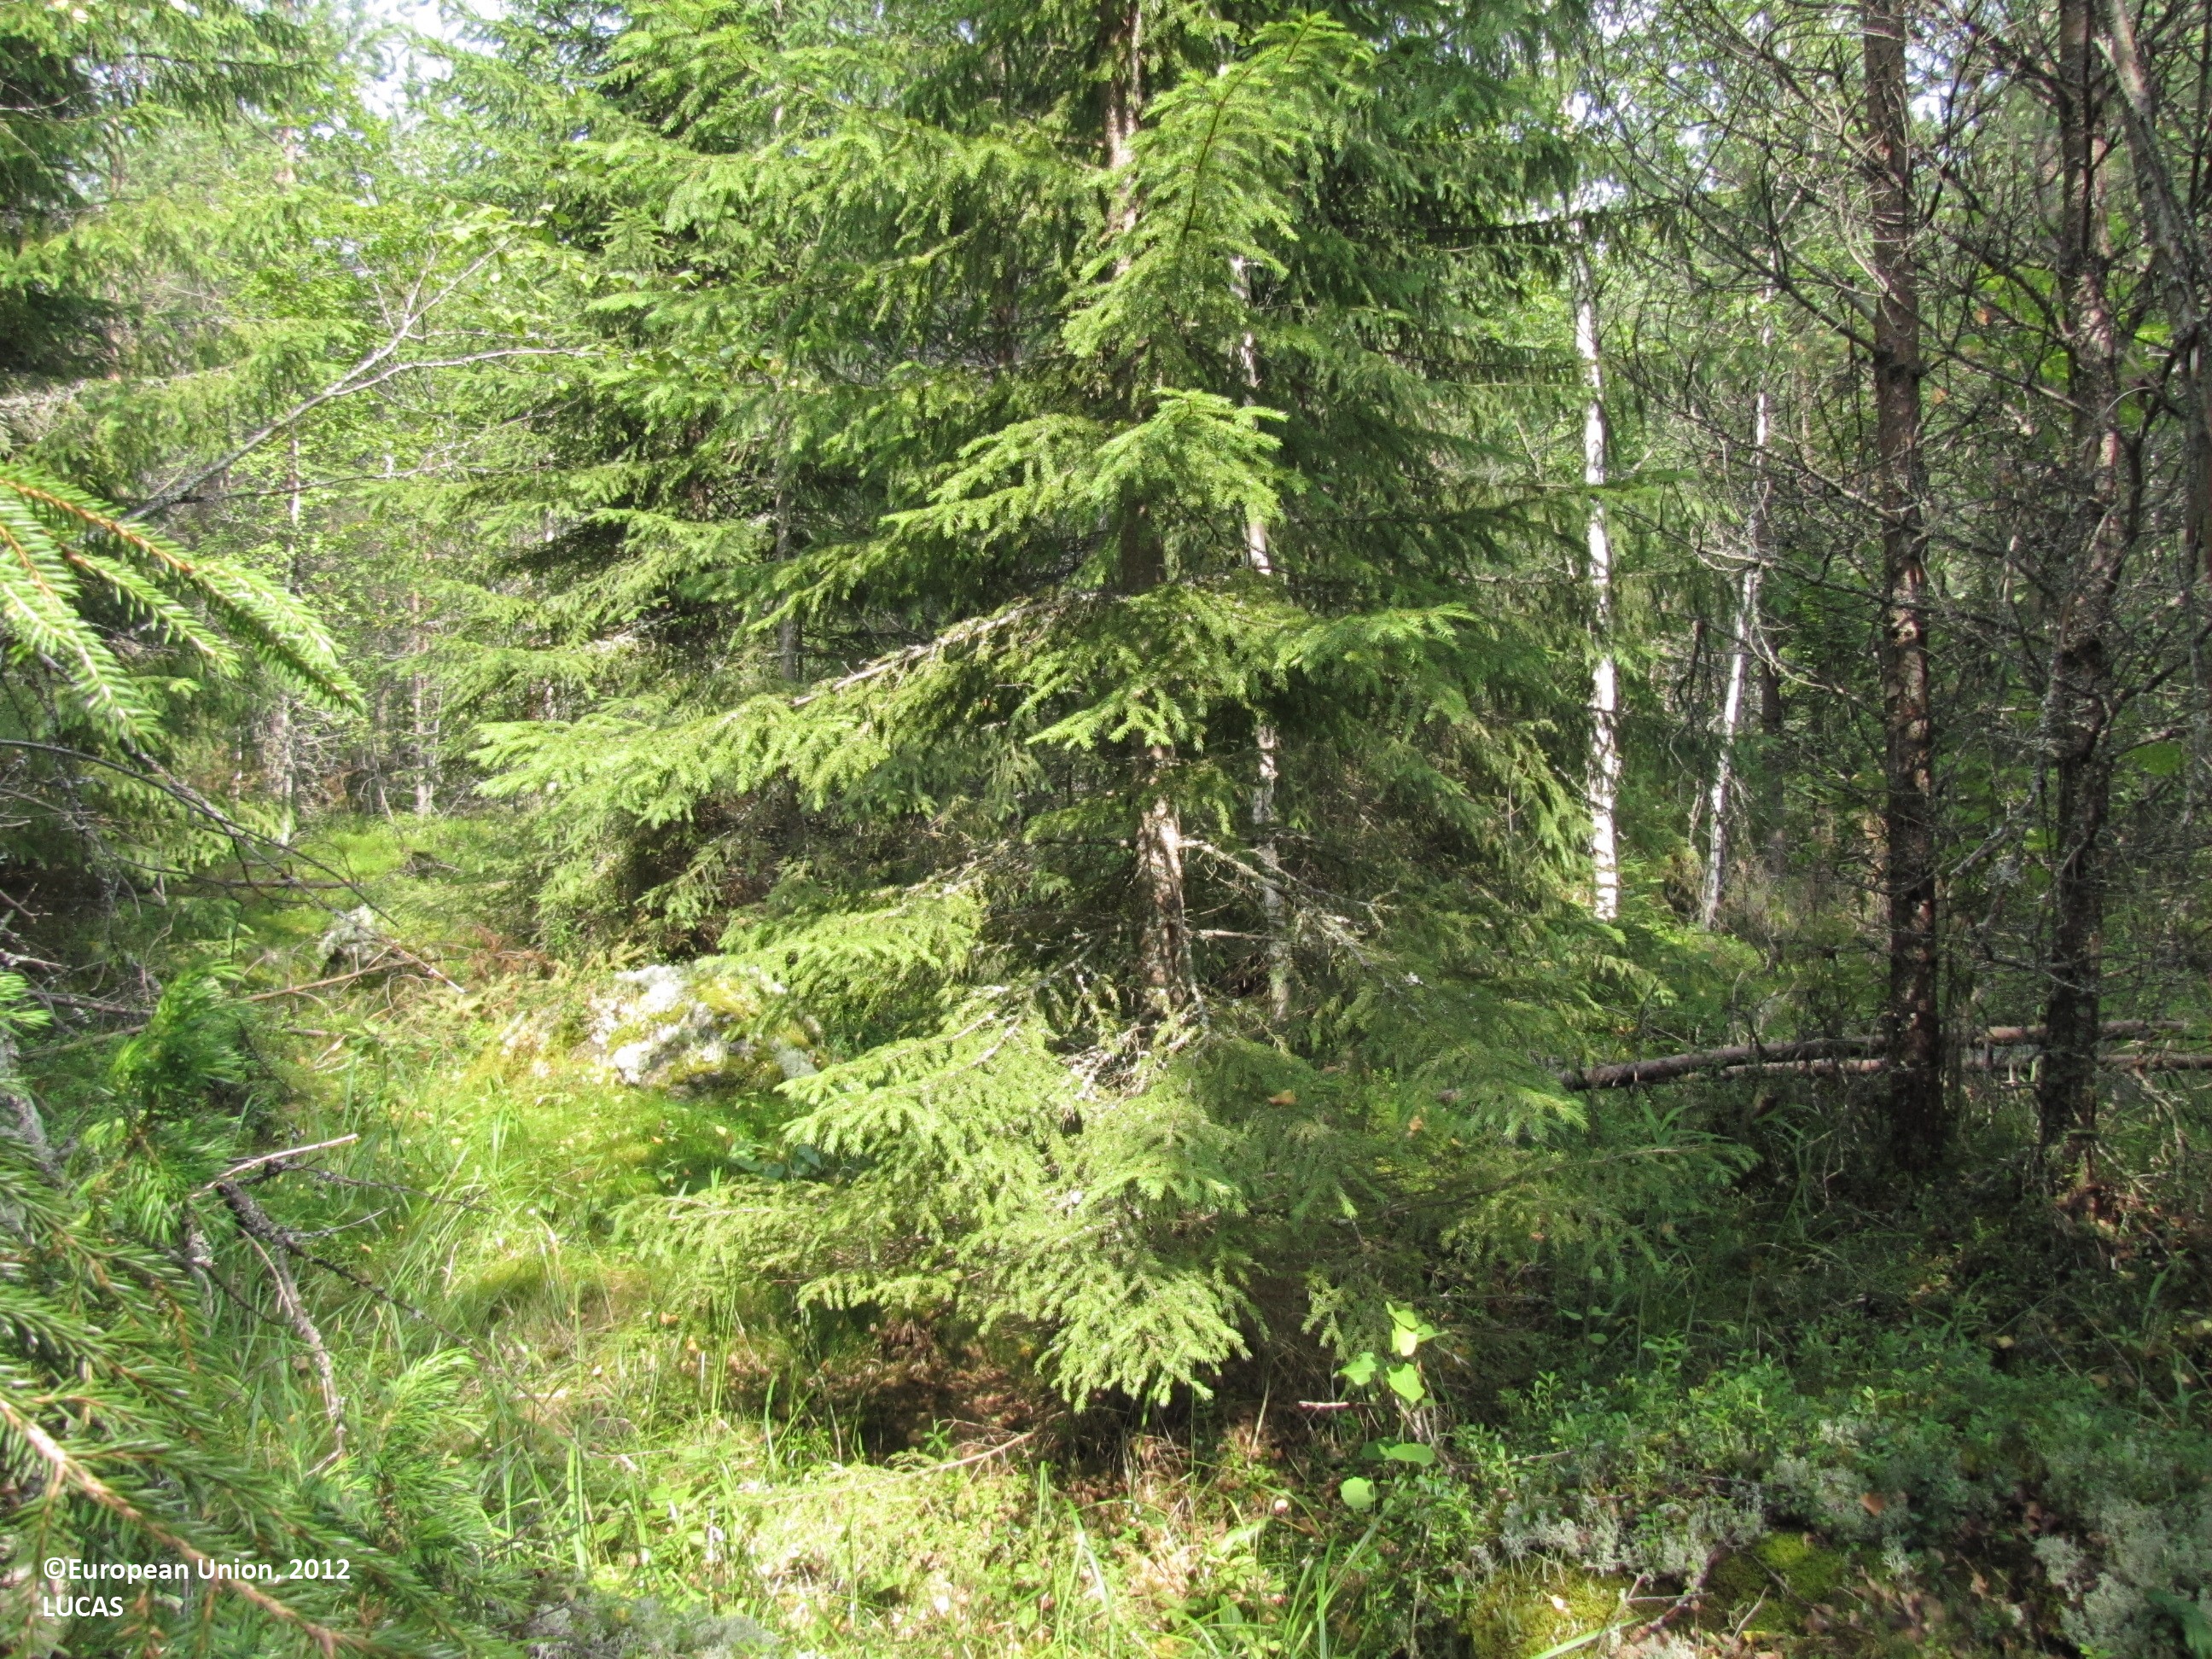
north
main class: Woodland
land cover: Spruce dominated mixed woodland
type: boreal forest
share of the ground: > 75 %
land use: Forestry
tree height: > 5 m
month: July
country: FI
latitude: 61.9650
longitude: 23.2889
